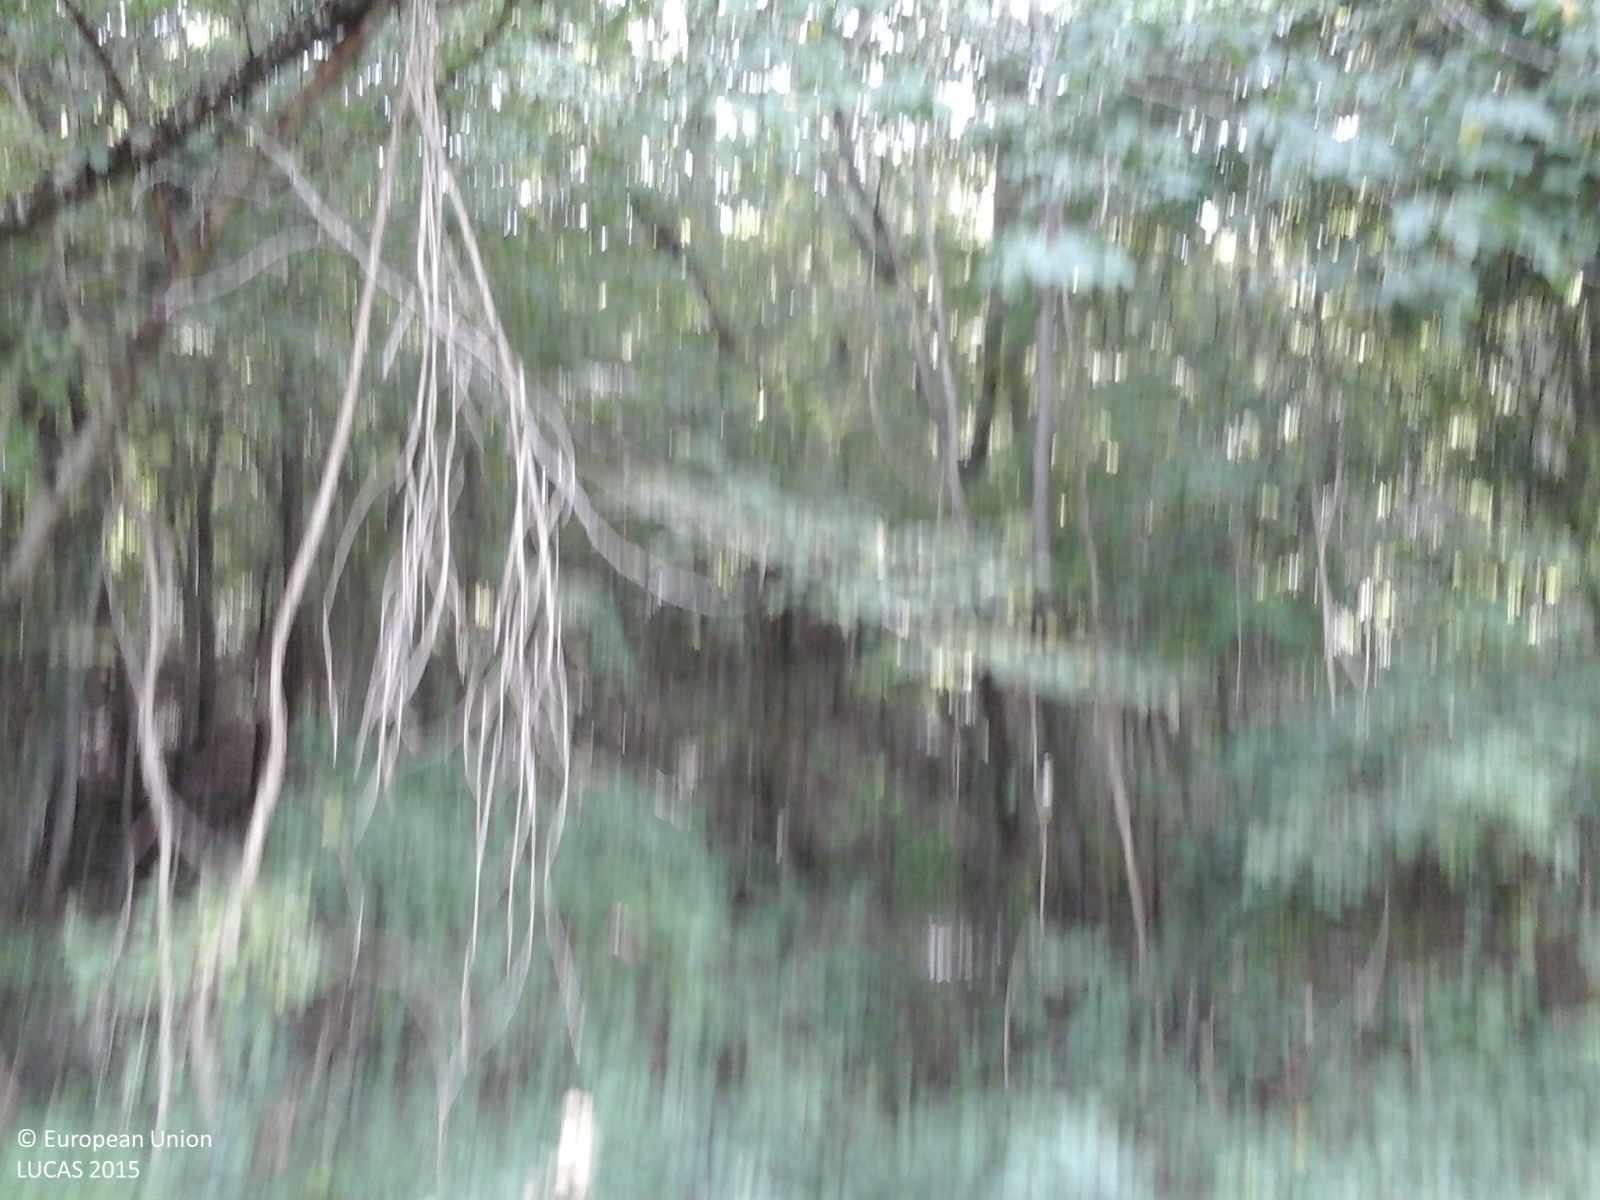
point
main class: Woodland
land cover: Broadleaved woodland
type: thermophilous deciduous forest
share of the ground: > 75 %
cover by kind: broadleaved forest trees 100 %
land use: Forestry
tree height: > 5 m
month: September
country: IT
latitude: 41.5449
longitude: 13.9772
